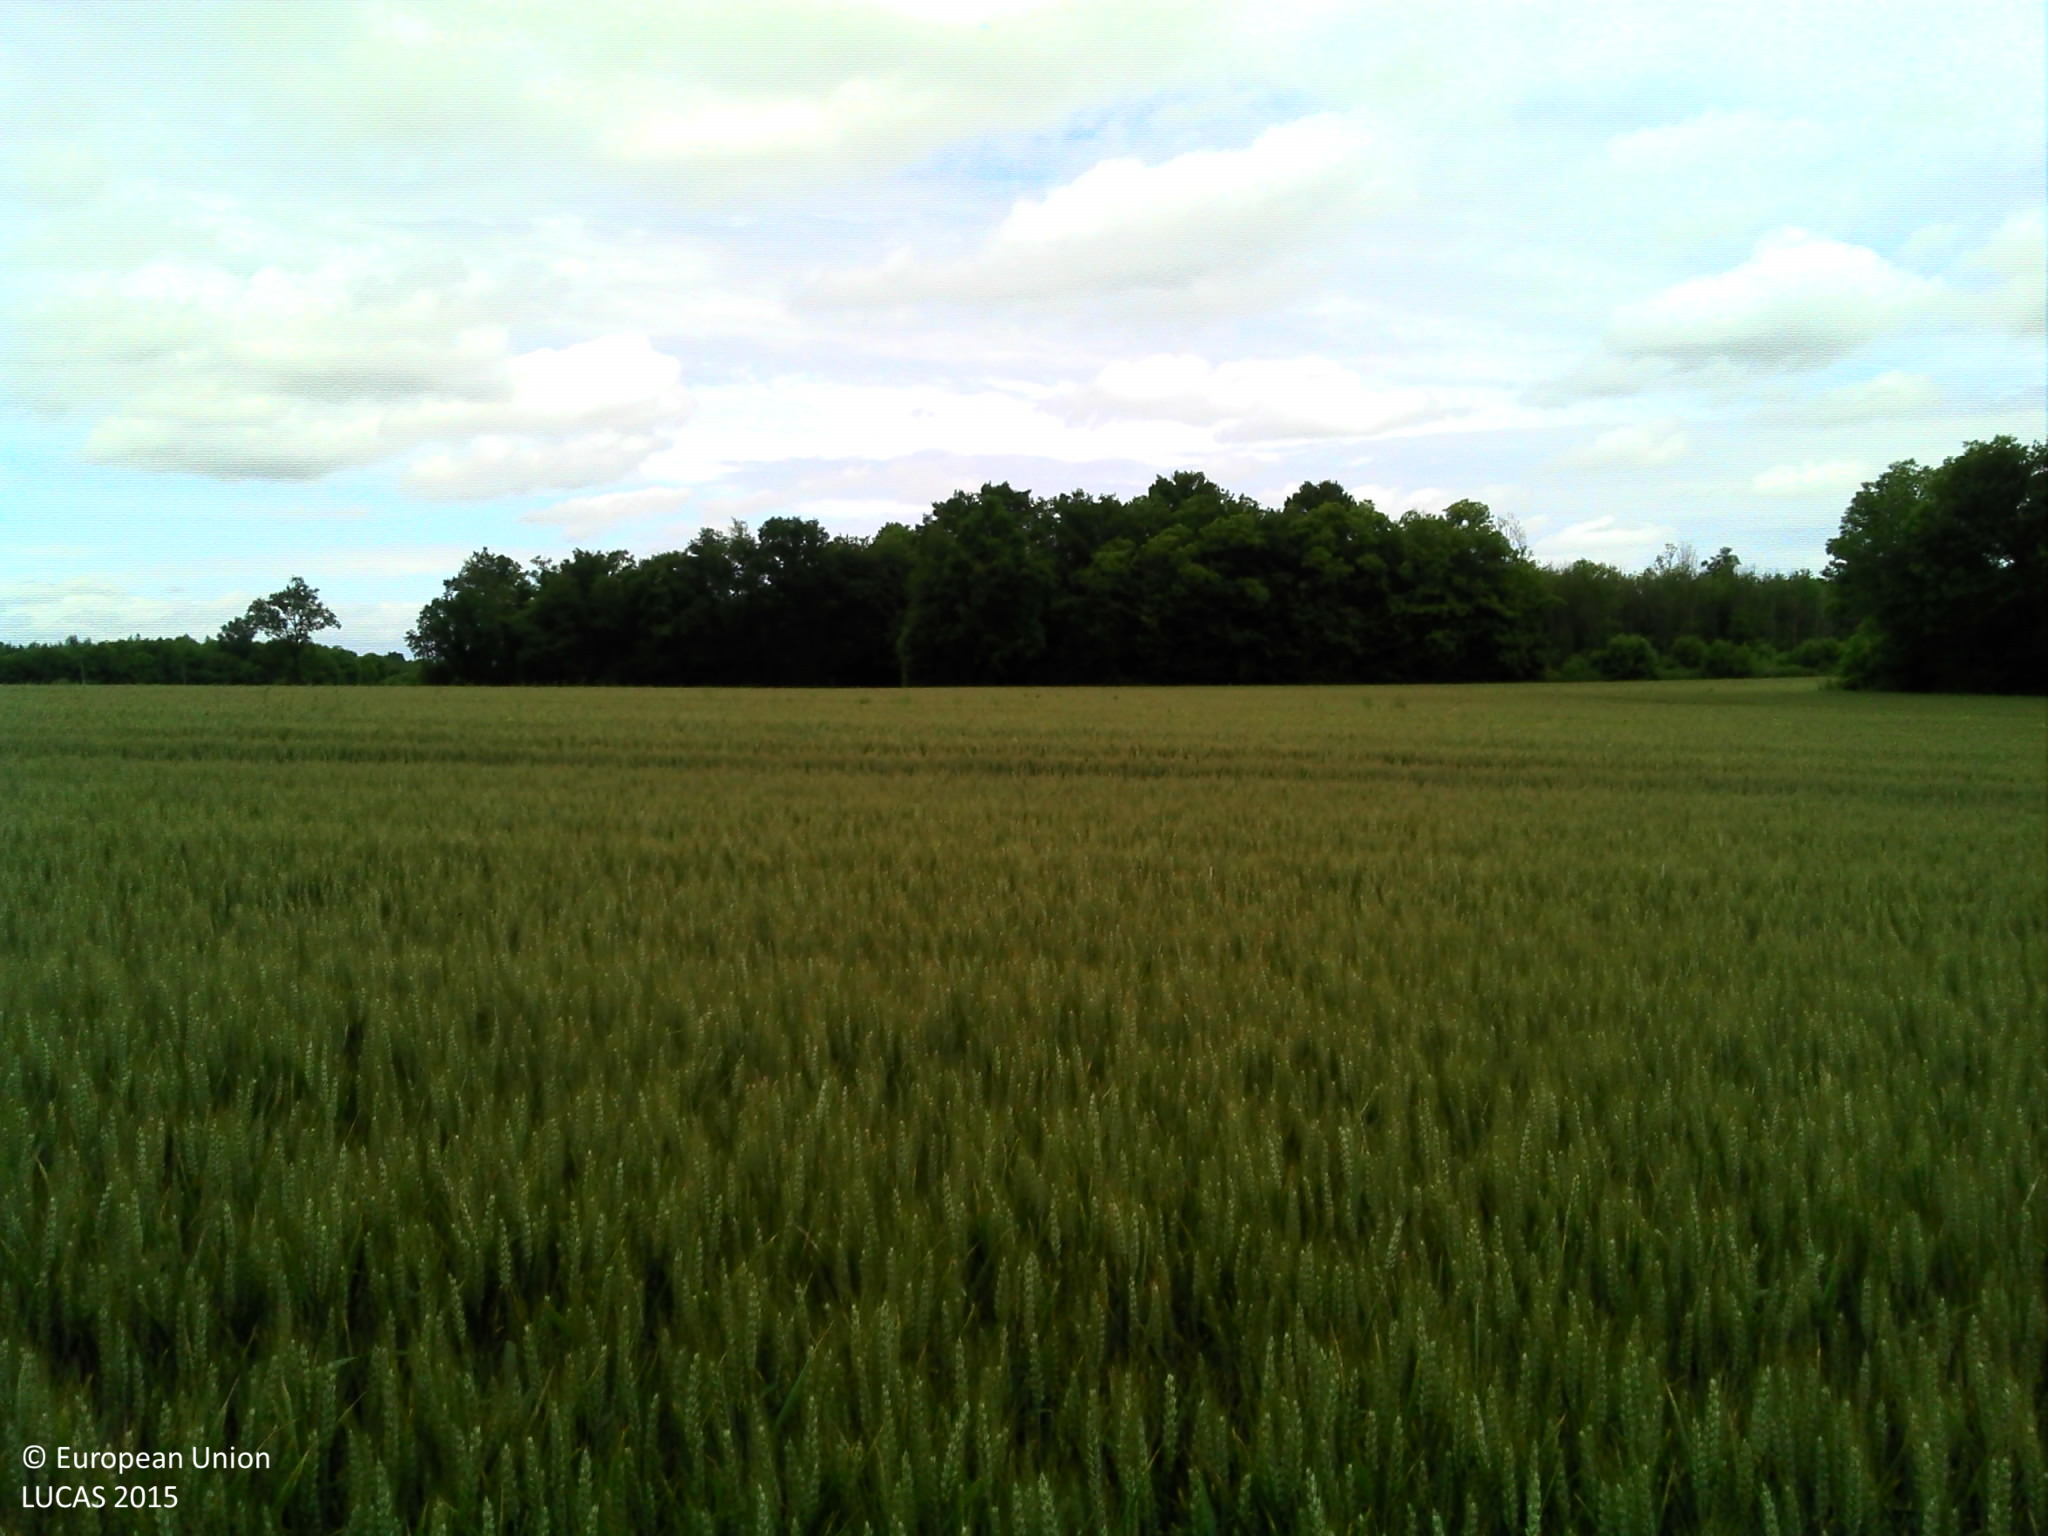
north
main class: Cropland
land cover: Common wheat
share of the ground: > 75 %
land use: Agriculture (excluding fallow land and kitchen gardens)
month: June
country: FR
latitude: 46.0260
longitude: 0.3853
